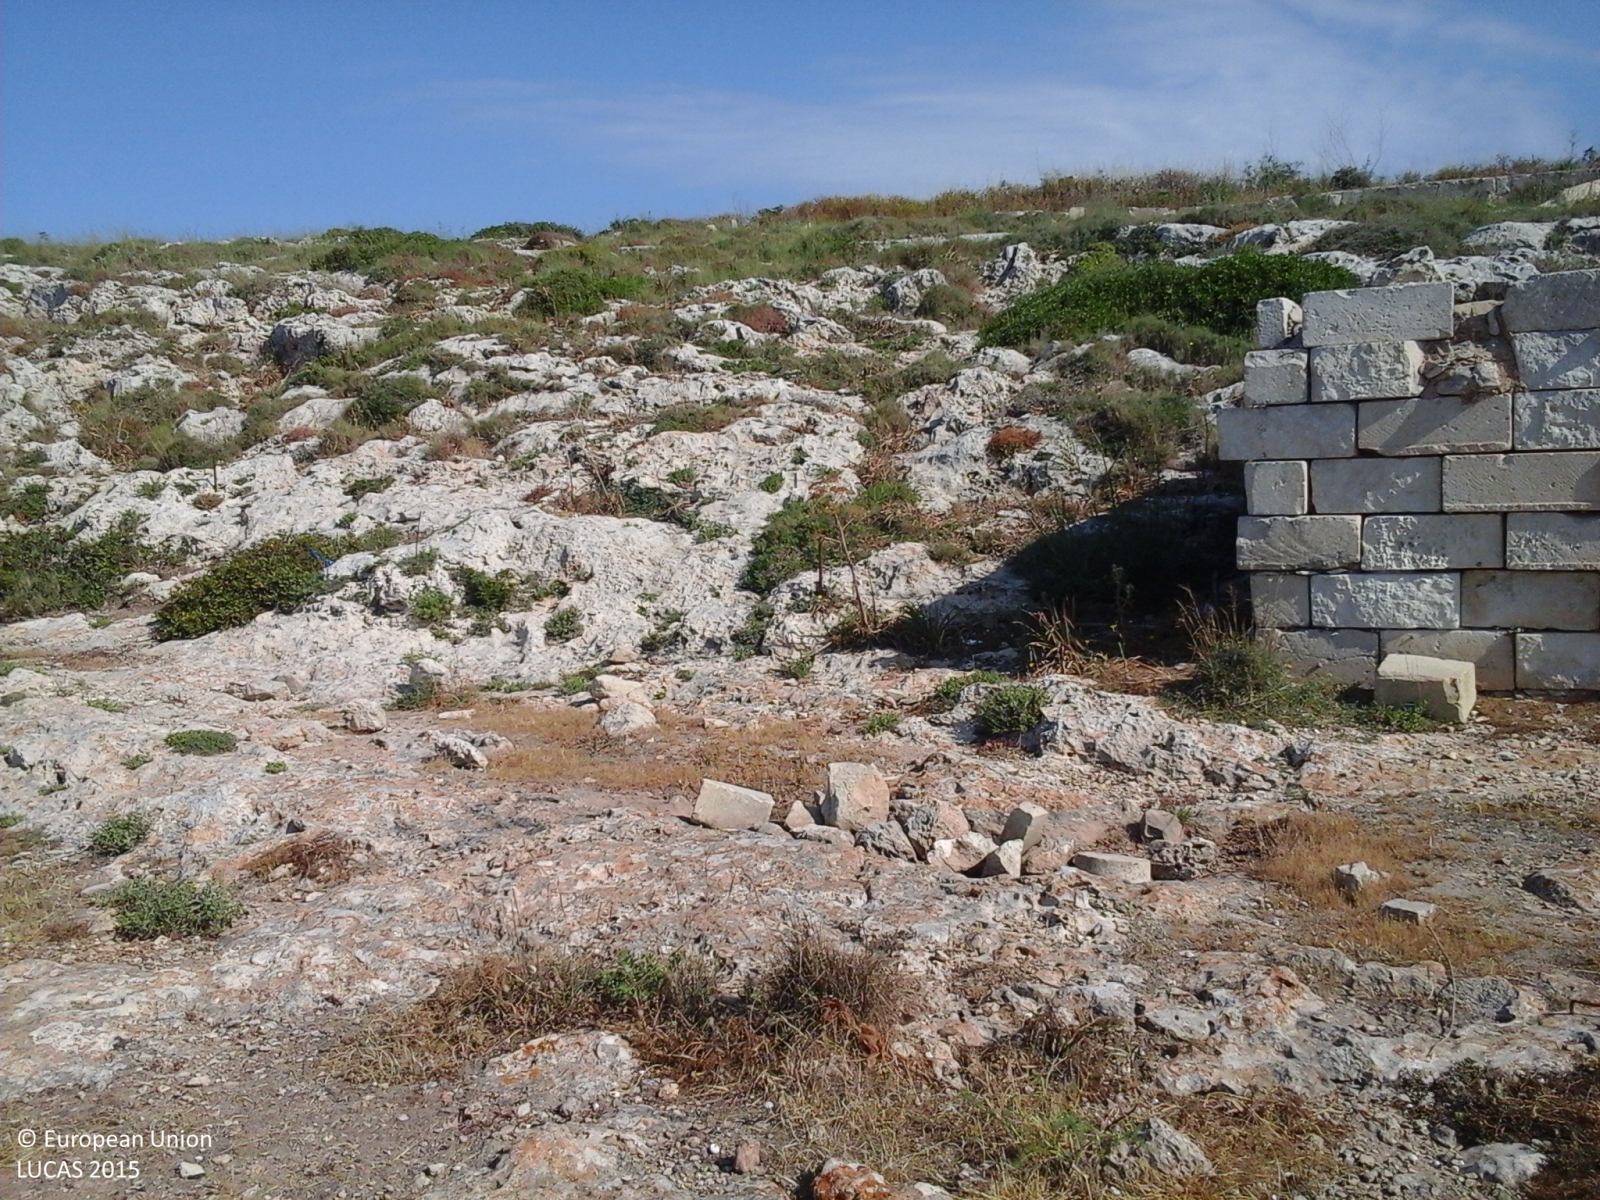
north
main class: Grassland
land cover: Grassland without tree/shrub cover
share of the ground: 50 - 75 %
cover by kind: herbaceous plants 50 %, consolidated bare surface 50 %
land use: Semi-natural and natural areas not in use
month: May
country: MT
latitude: 35.8442
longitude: 14.3988
